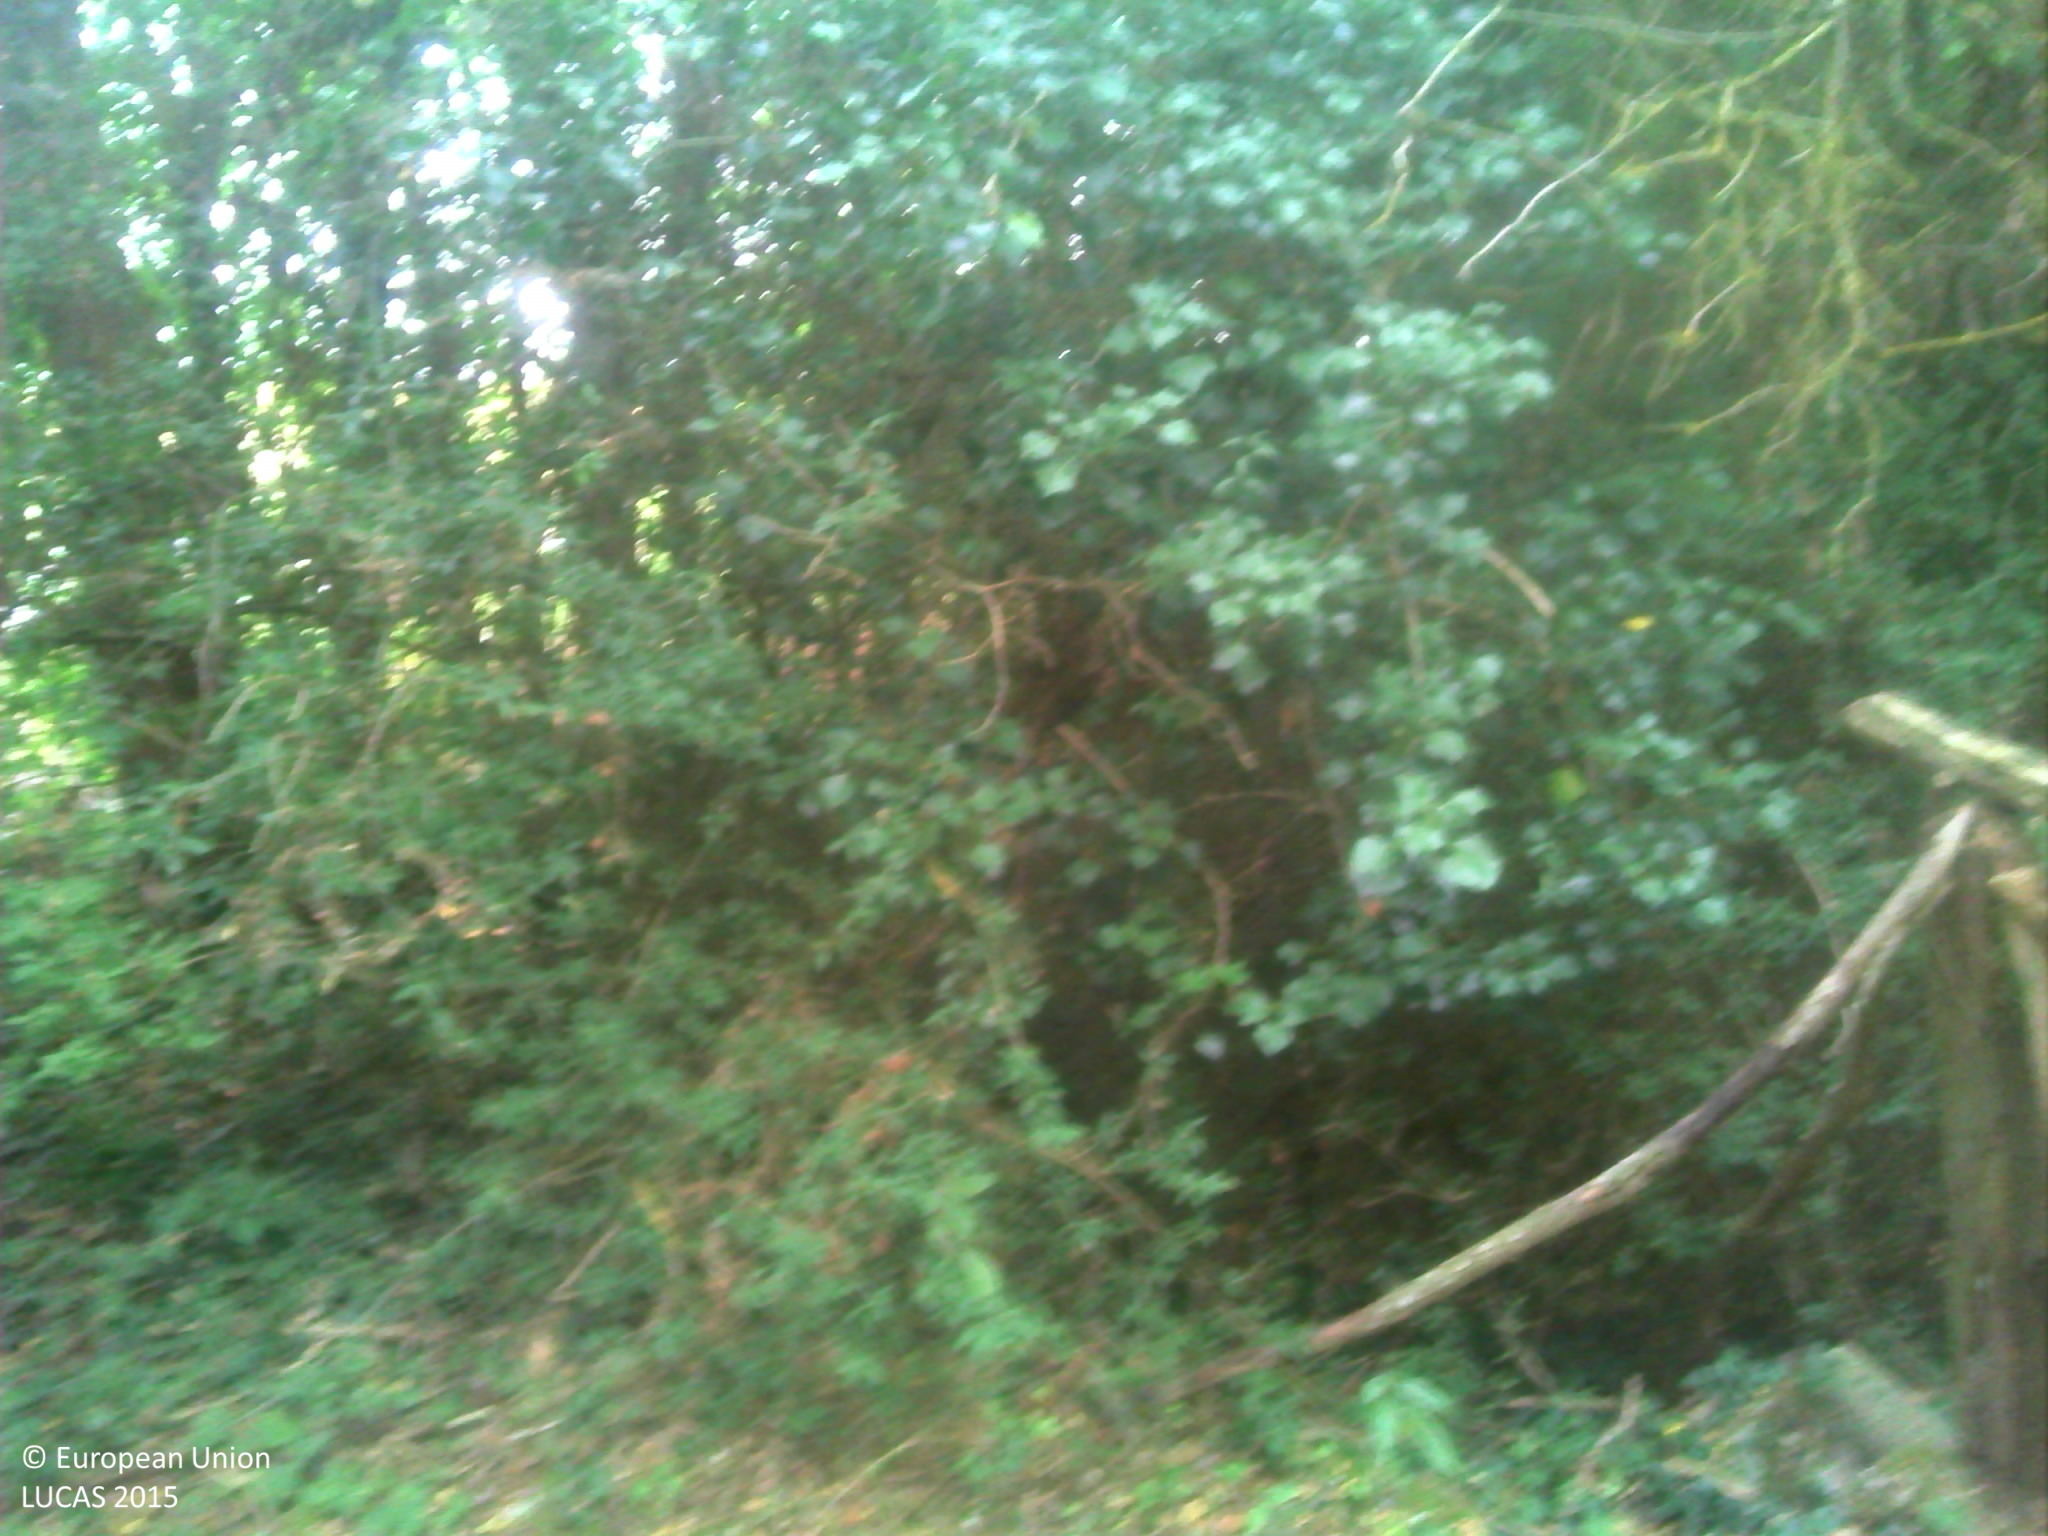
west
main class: Woodland
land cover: Broadleaved woodland
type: mesophytic deciduous forest
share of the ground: > 75 %
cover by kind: broadleaved forest trees 50 %, herbaceous plants 50 %
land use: Semi-natural and natural areas not in use
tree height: > 5 m
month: July
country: FR
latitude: 47.7167
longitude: 1.3062
